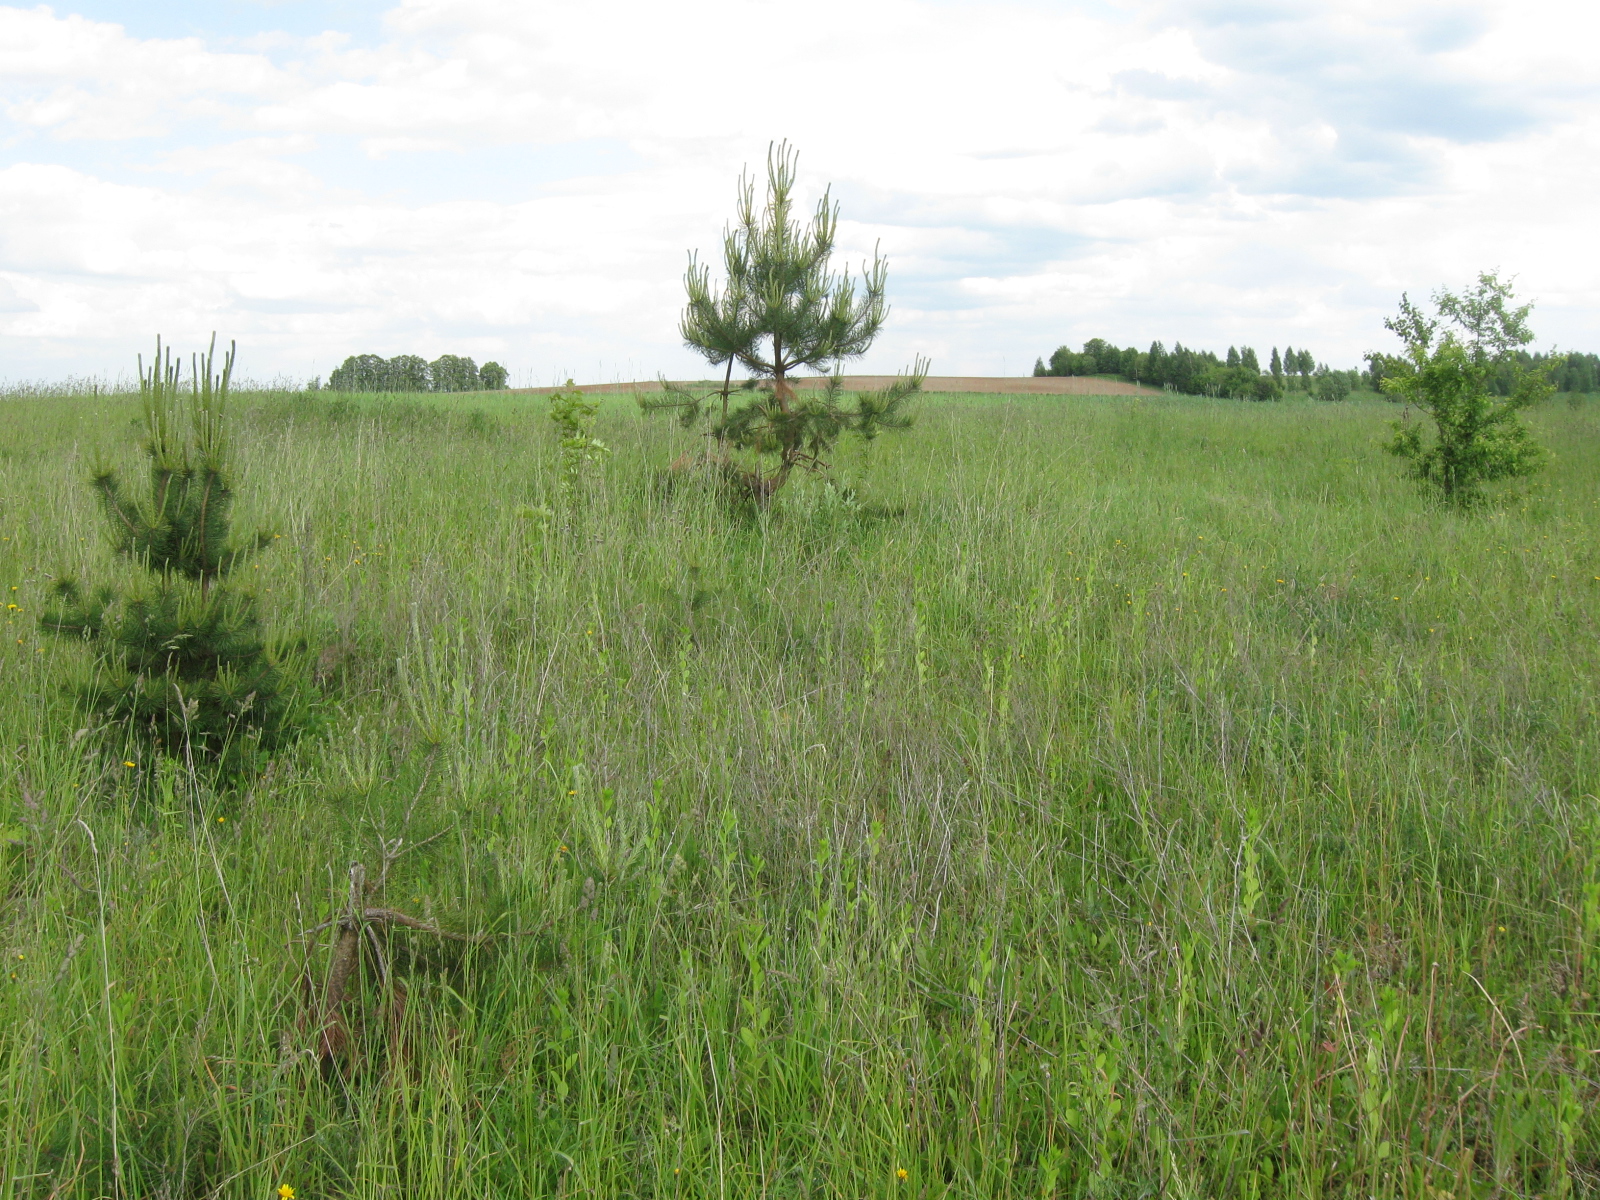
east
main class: Grassland
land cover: Grassland with sparse tree/shrub cover
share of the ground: > 75 %
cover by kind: herbaceous plants 90 %, coniferous forest trees 5 %, unconsolidated bare surface 5 %
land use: Agriculture (excluding fallow land and kitchen gardens)
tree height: < 5 m
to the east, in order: Grassland with sparse tree/shrub cover; Tracks; Grass margins; Common wheat; Grassland without tree/shrub cover; Sugar beet; Barley; Grassland without tree/shrub cover
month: June
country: LT
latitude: 54.2965
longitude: 23.8723
